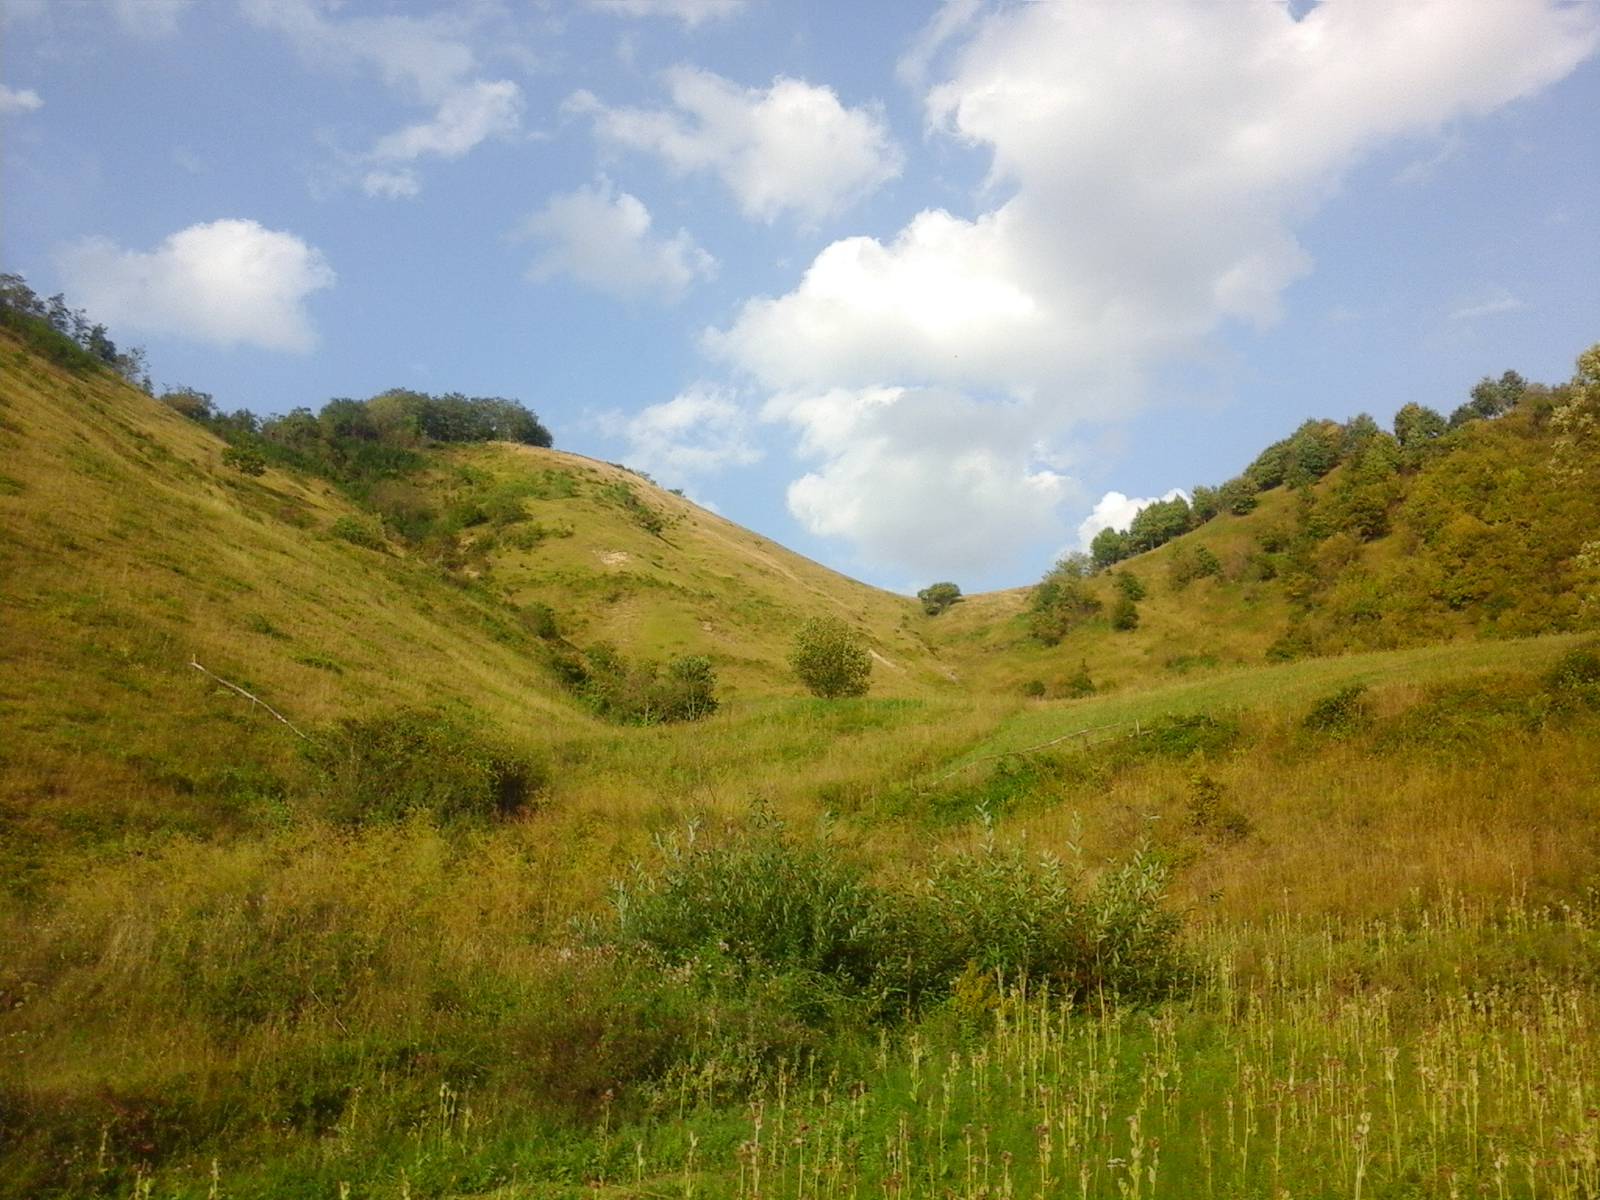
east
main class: Grassland
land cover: Grassland with sparse tree/shrub cover
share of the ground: > 75 %
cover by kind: herbaceous plants 95 %, broadleaved forest trees 5 %
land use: Agriculture (excluding fallow land and kitchen gardens)
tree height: > 5 m
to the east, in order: Grassland with sparse tree/shrub cover; Broadleaved woodland
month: September
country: RO
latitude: 47.7497
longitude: 24.2416
